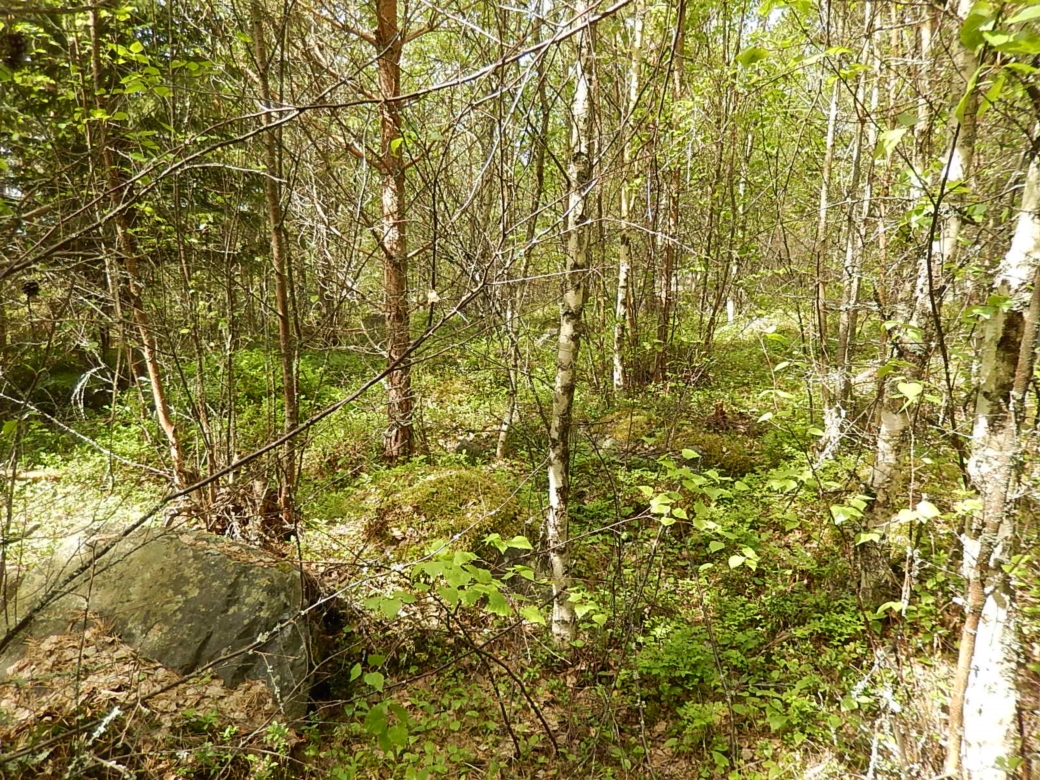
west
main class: Woodland
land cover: Pine dominated mixed woodland
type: boreal forest
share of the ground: > 75 %
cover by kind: coniferous forest trees 50 %, broadleaved forest trees 40 %, herbaceous plants 10 %
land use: Forestry
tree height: > 5 m
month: June
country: FI
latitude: 61.8800
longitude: 21.4780
